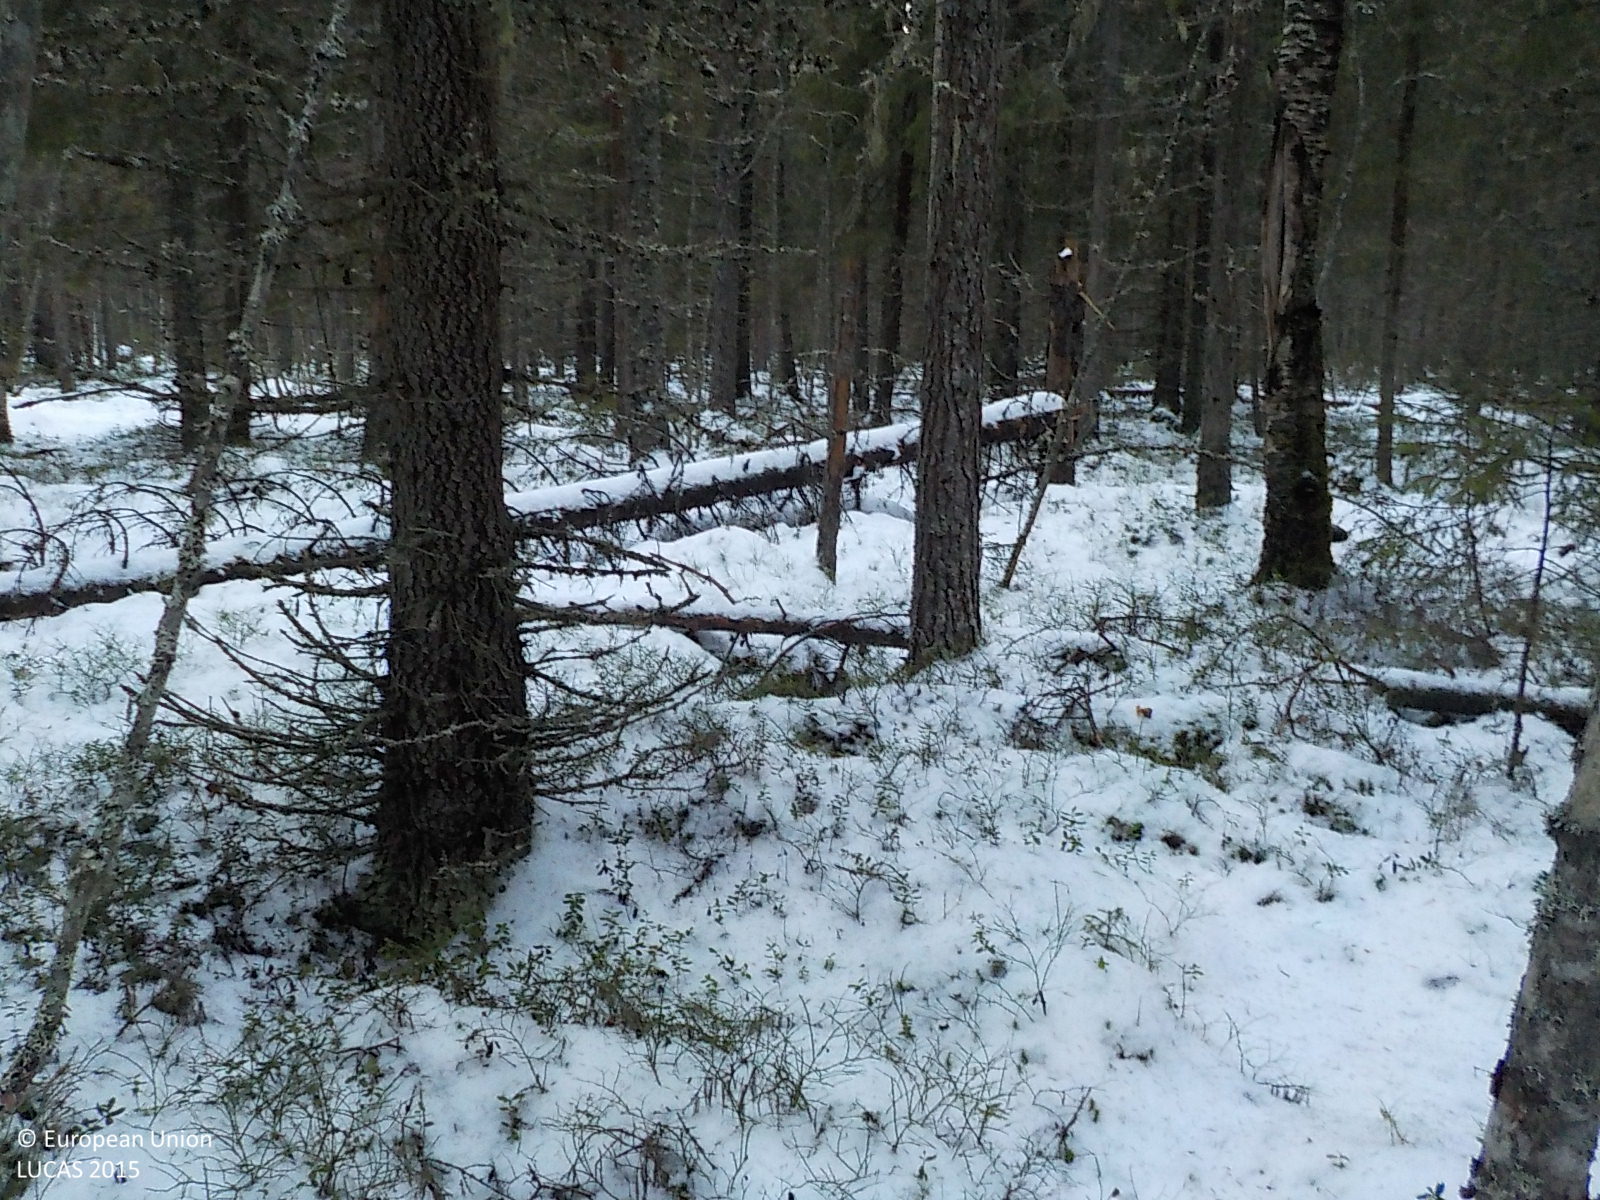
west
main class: Woodland
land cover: Spruce dominated coniferous woodland
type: boreal forest
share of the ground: > 75 %
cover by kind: coniferous forest trees 75 %, shrubs 10 %, broadleaved forest trees 5 %, herbaceous plants 5 %, lichens and mosses 5 %
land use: Forestry
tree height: > 5 m
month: December
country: SE
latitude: 63.5150
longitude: 16.6664
